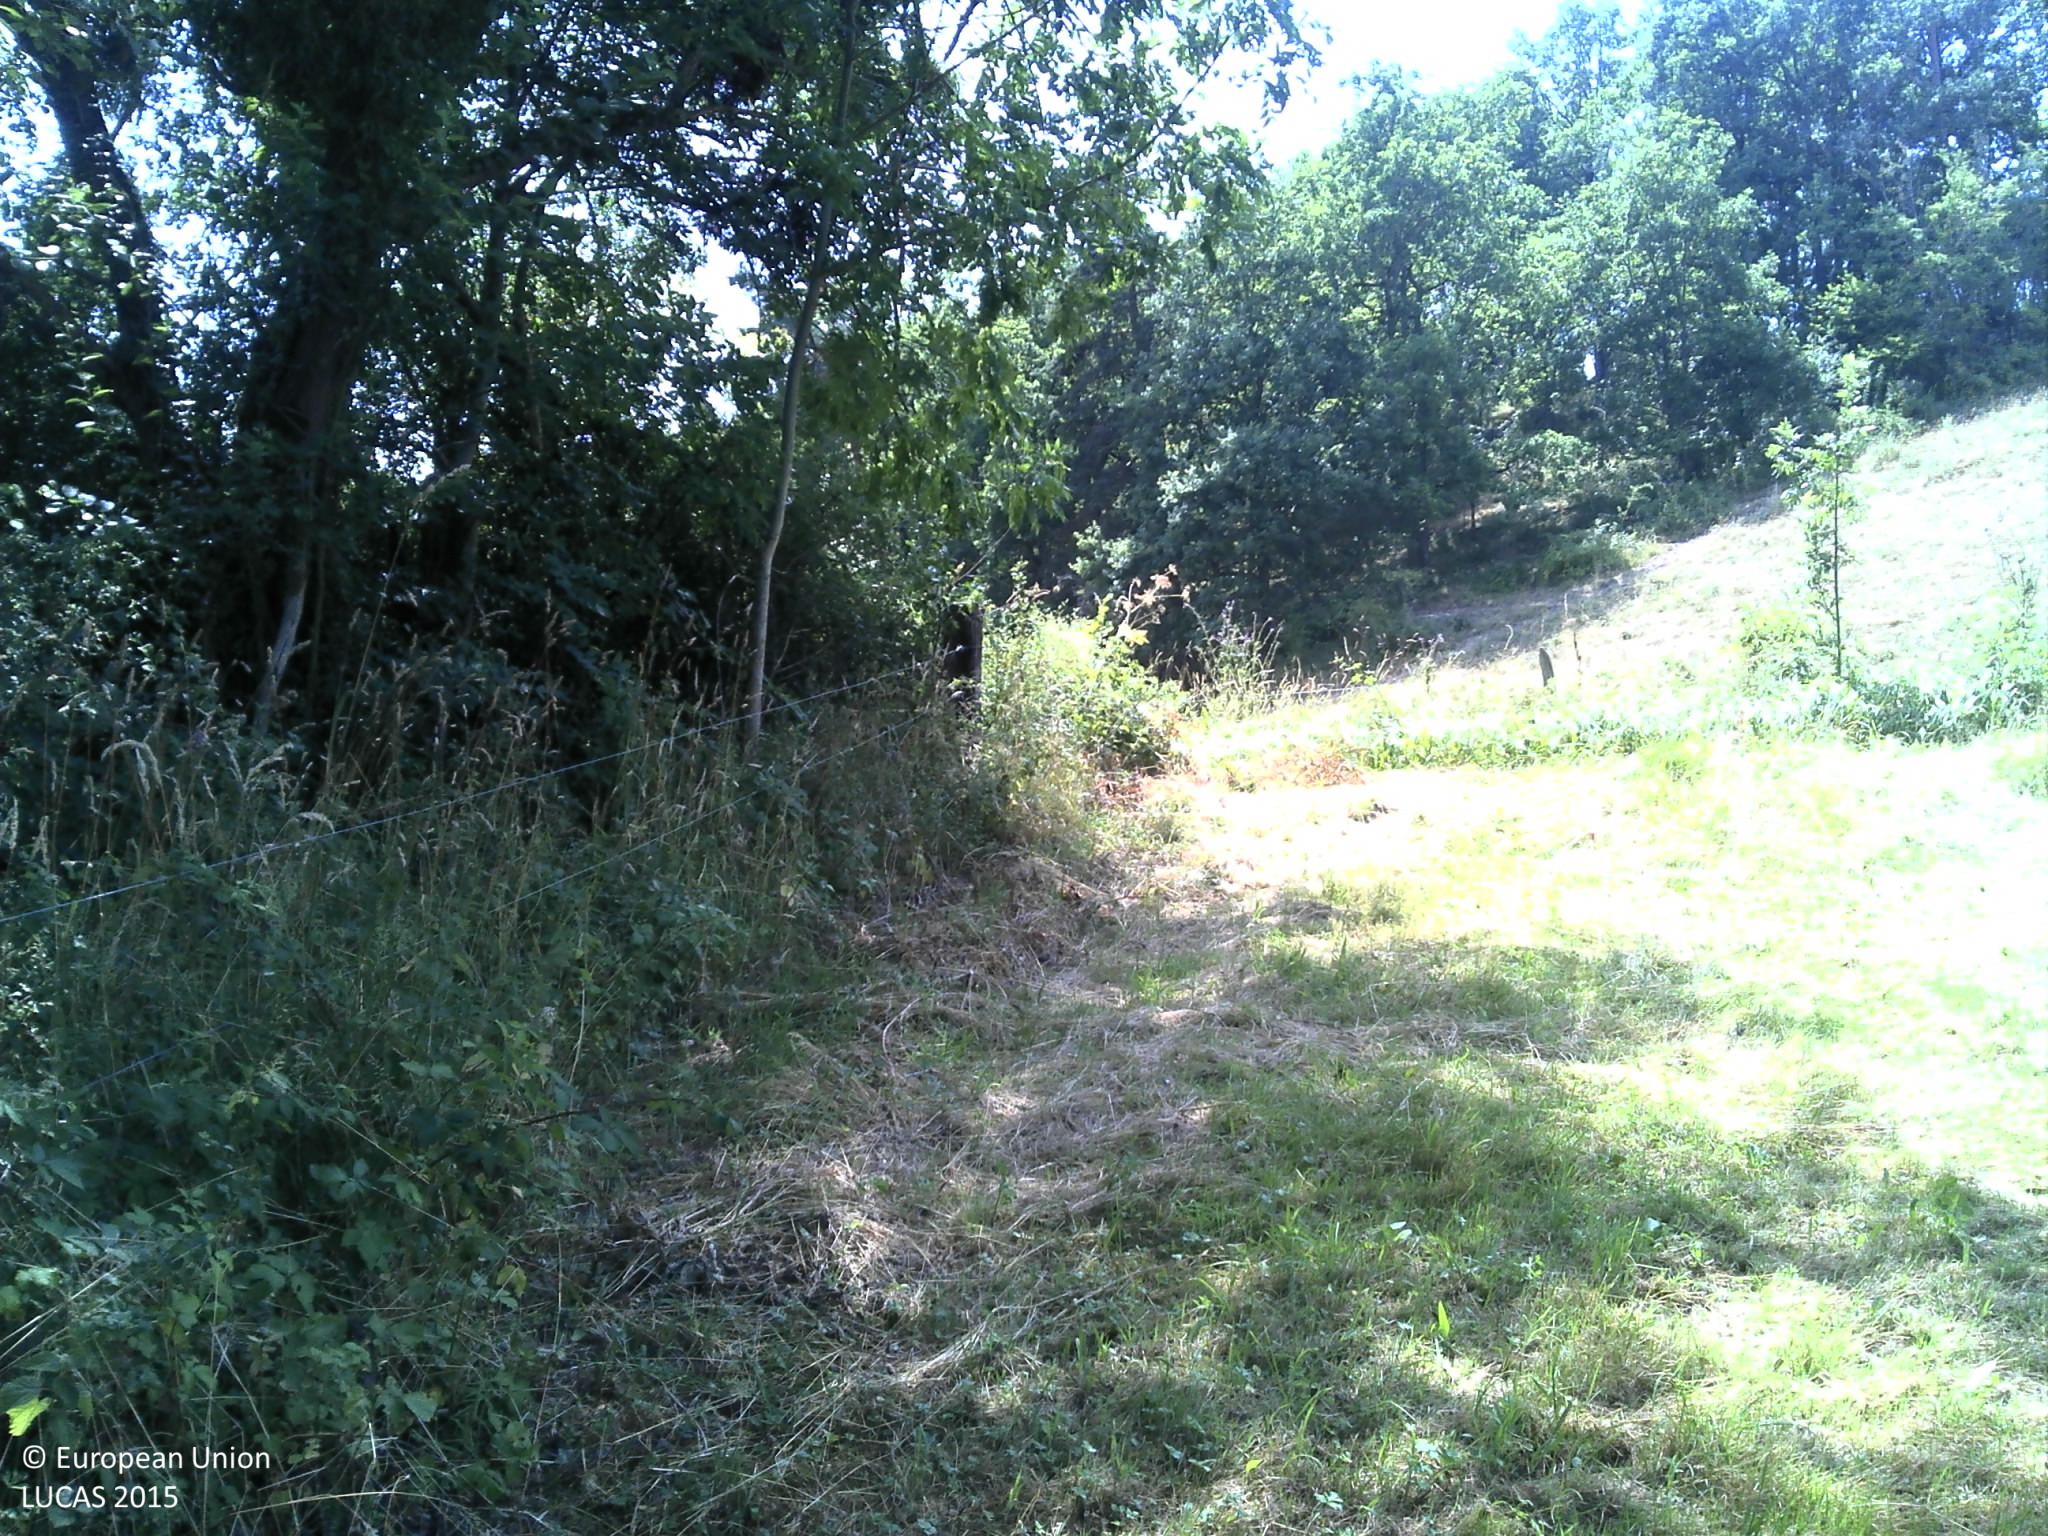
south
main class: Grassland
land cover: Grassland without tree/shrub cover
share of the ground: > 75 %
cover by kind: herbaceous plants 100 %
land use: Agriculture (excluding fallow land and kitchen gardens)
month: July
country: FR
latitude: 45.7142
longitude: 3.4107
